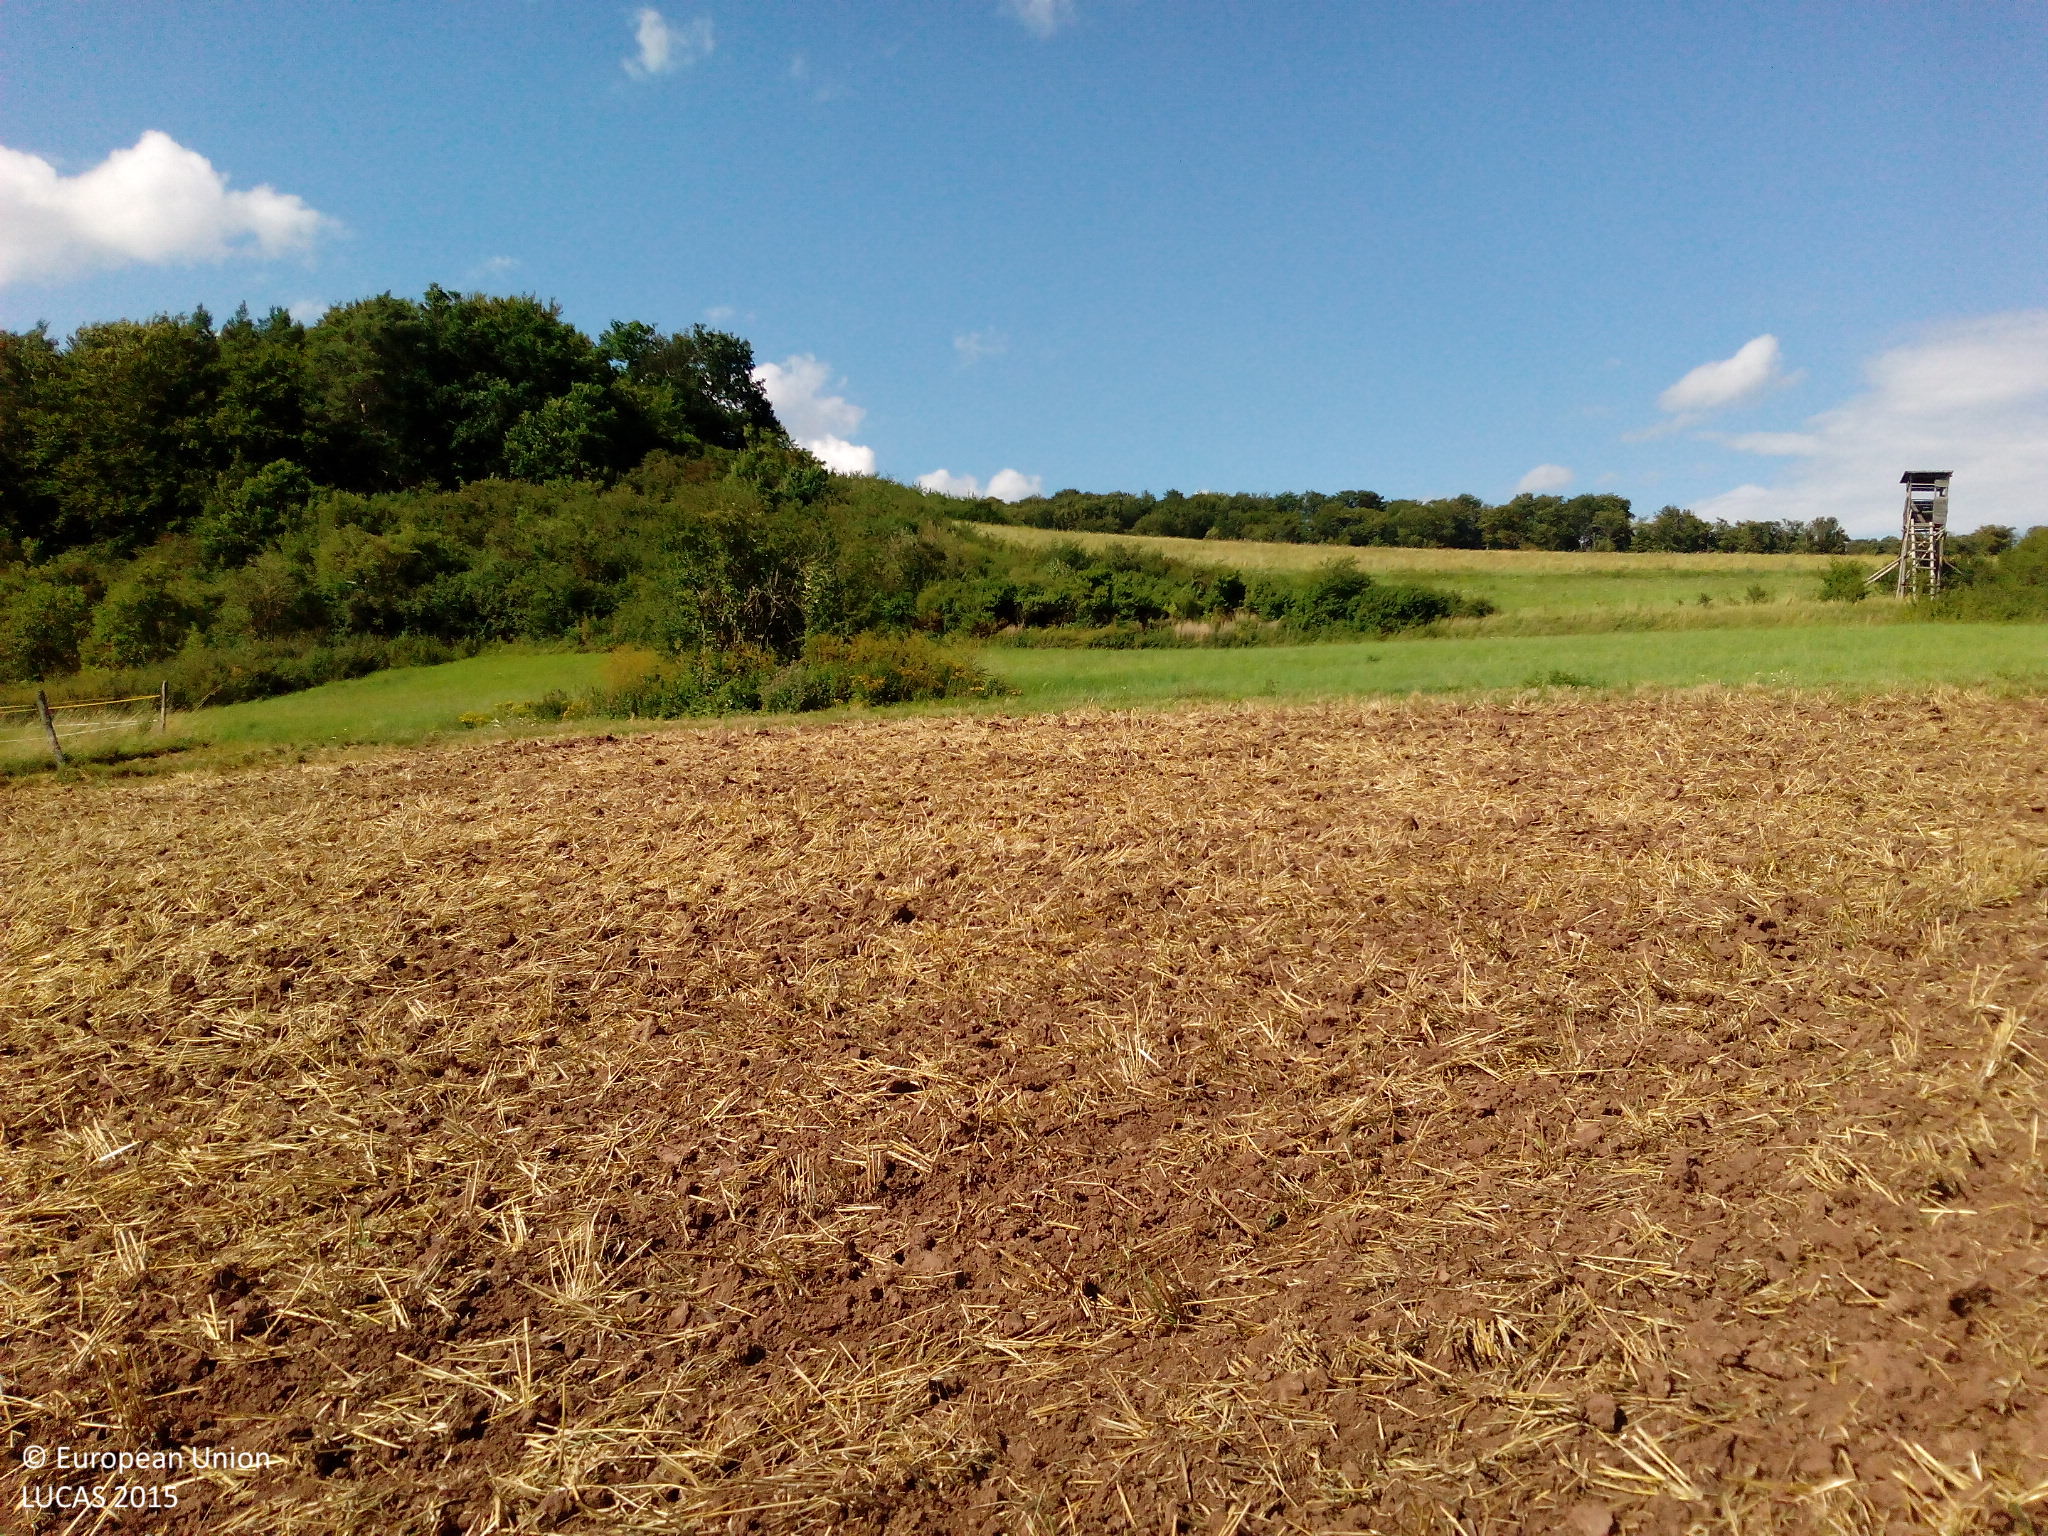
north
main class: Cropland
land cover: Barley
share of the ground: < 10 %
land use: Agriculture (excluding fallow land and kitchen gardens)
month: July
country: DE
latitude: 51.4230
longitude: 9.3530
